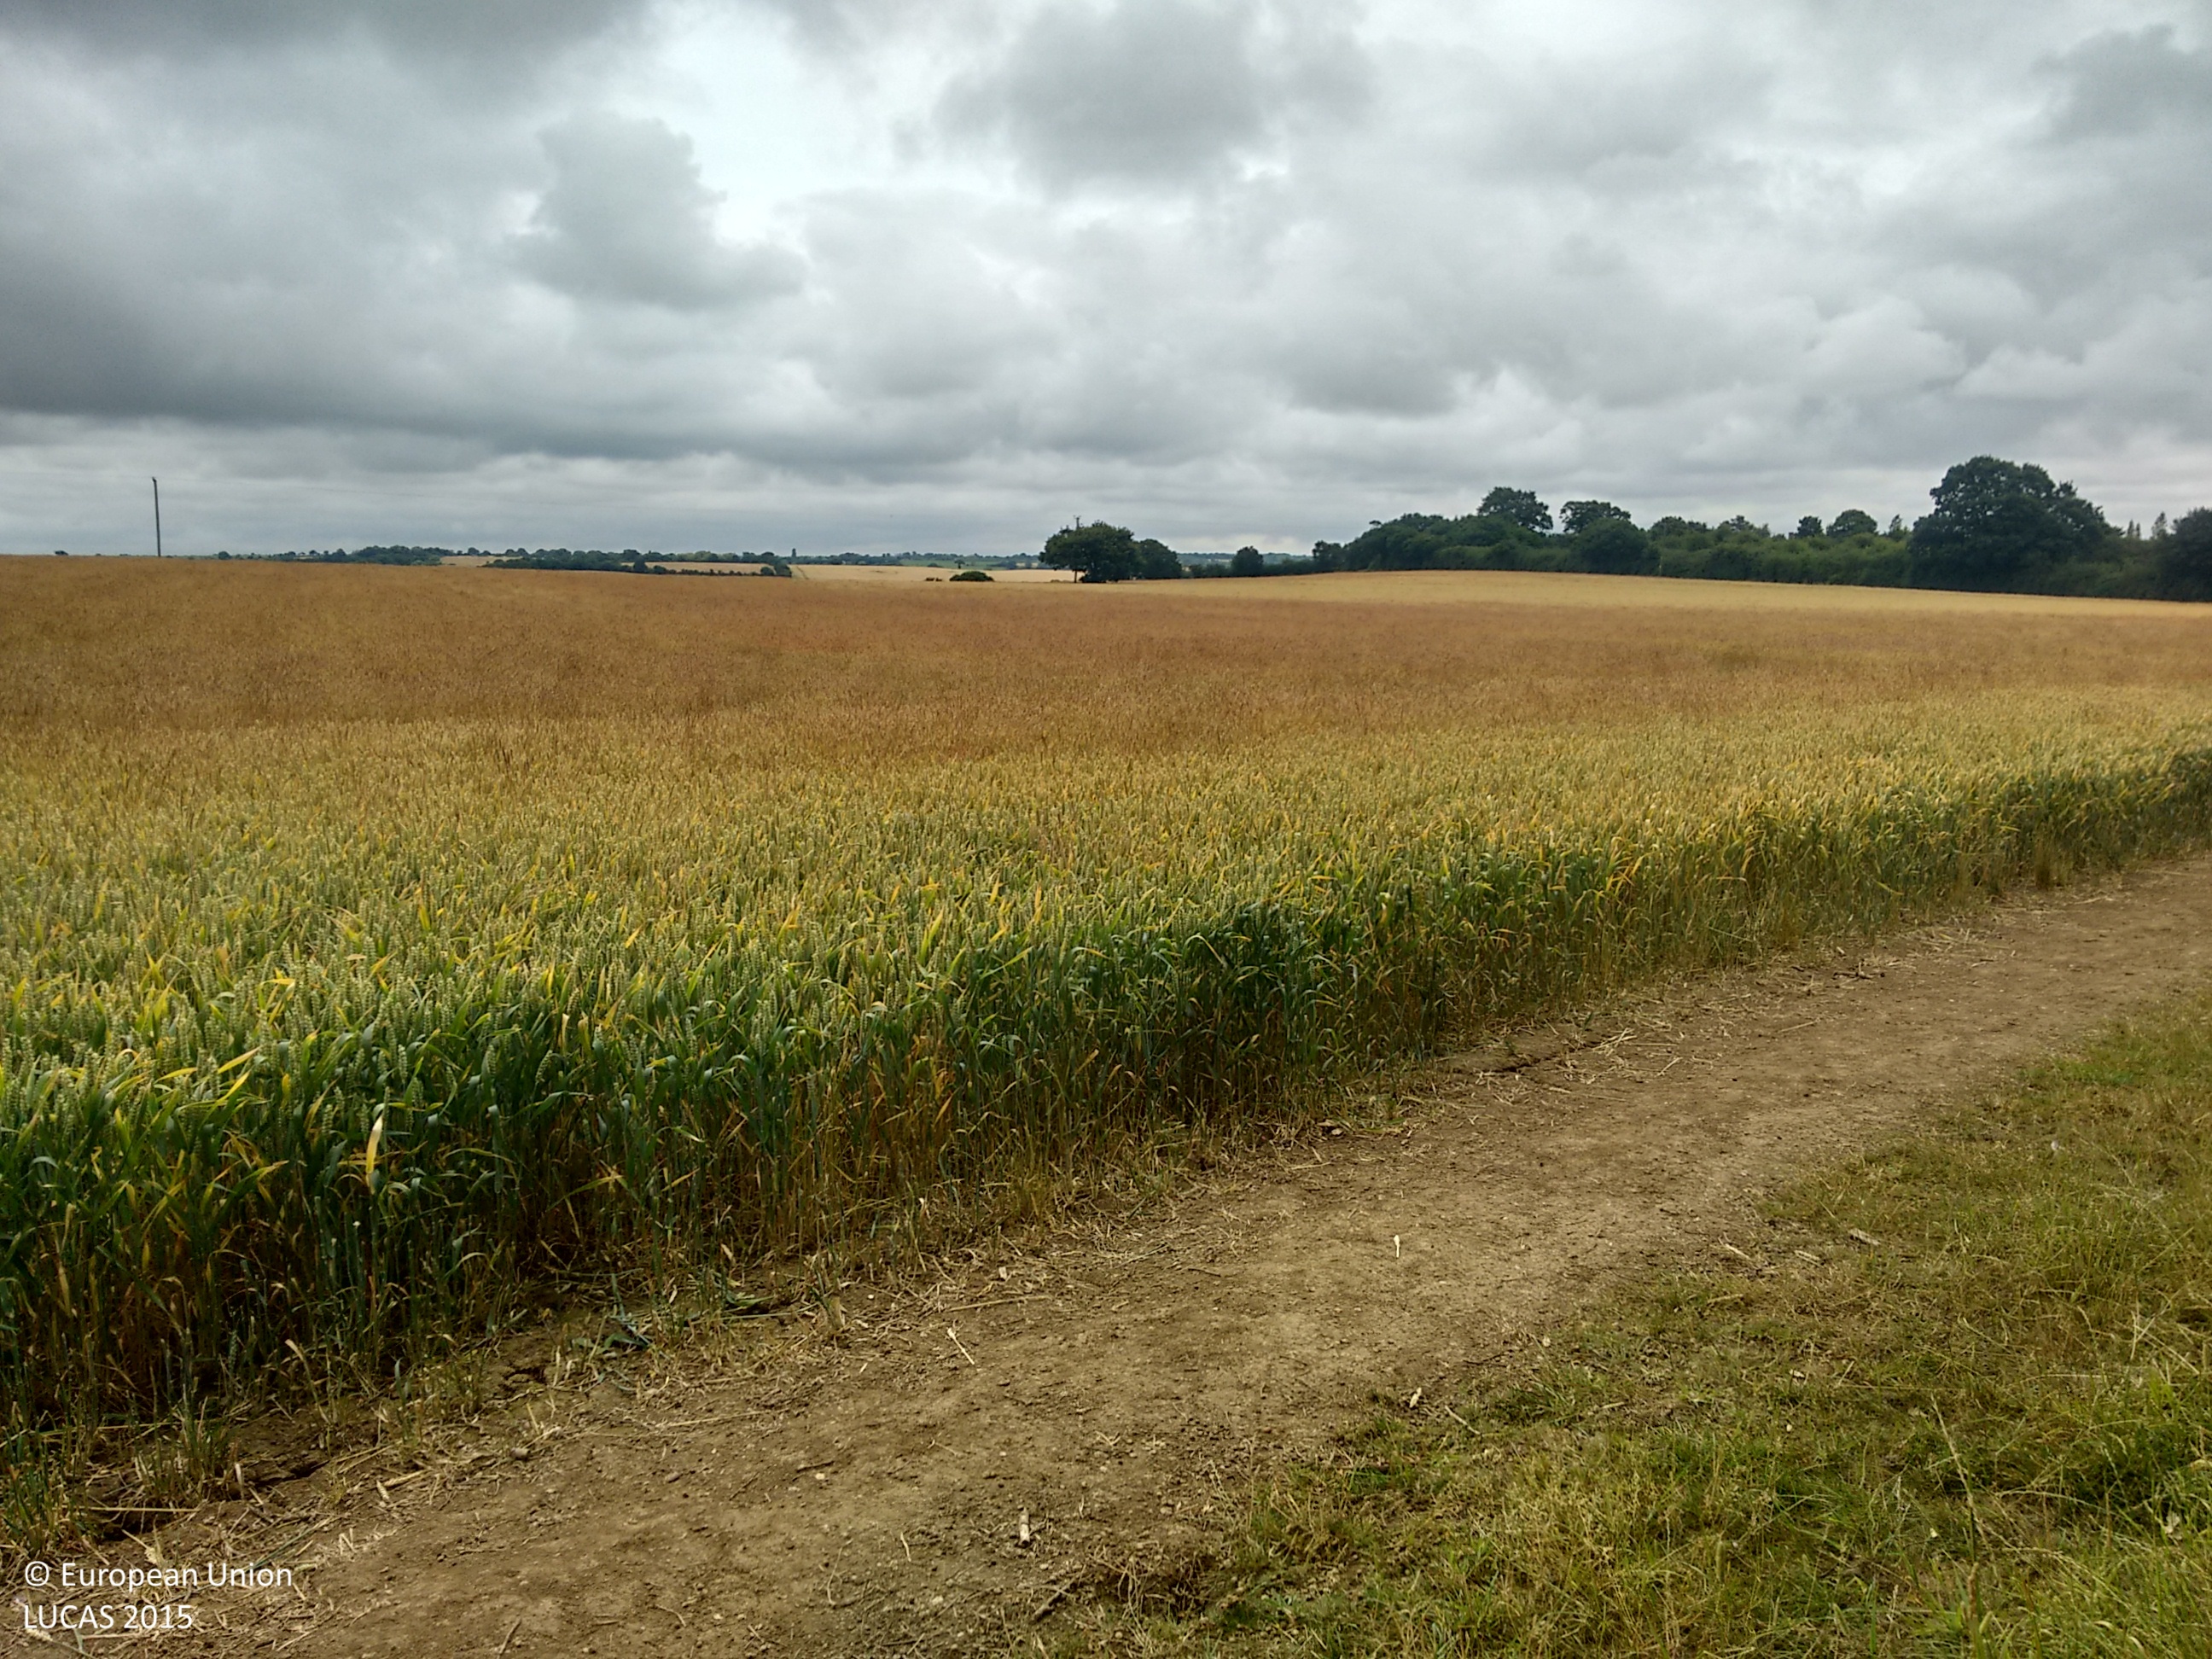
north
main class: Cropland
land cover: Common wheat
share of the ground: > 75 %
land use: Agriculture (excluding fallow land and kitchen gardens)
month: July
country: GB
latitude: 51.6390
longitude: 0.5661
